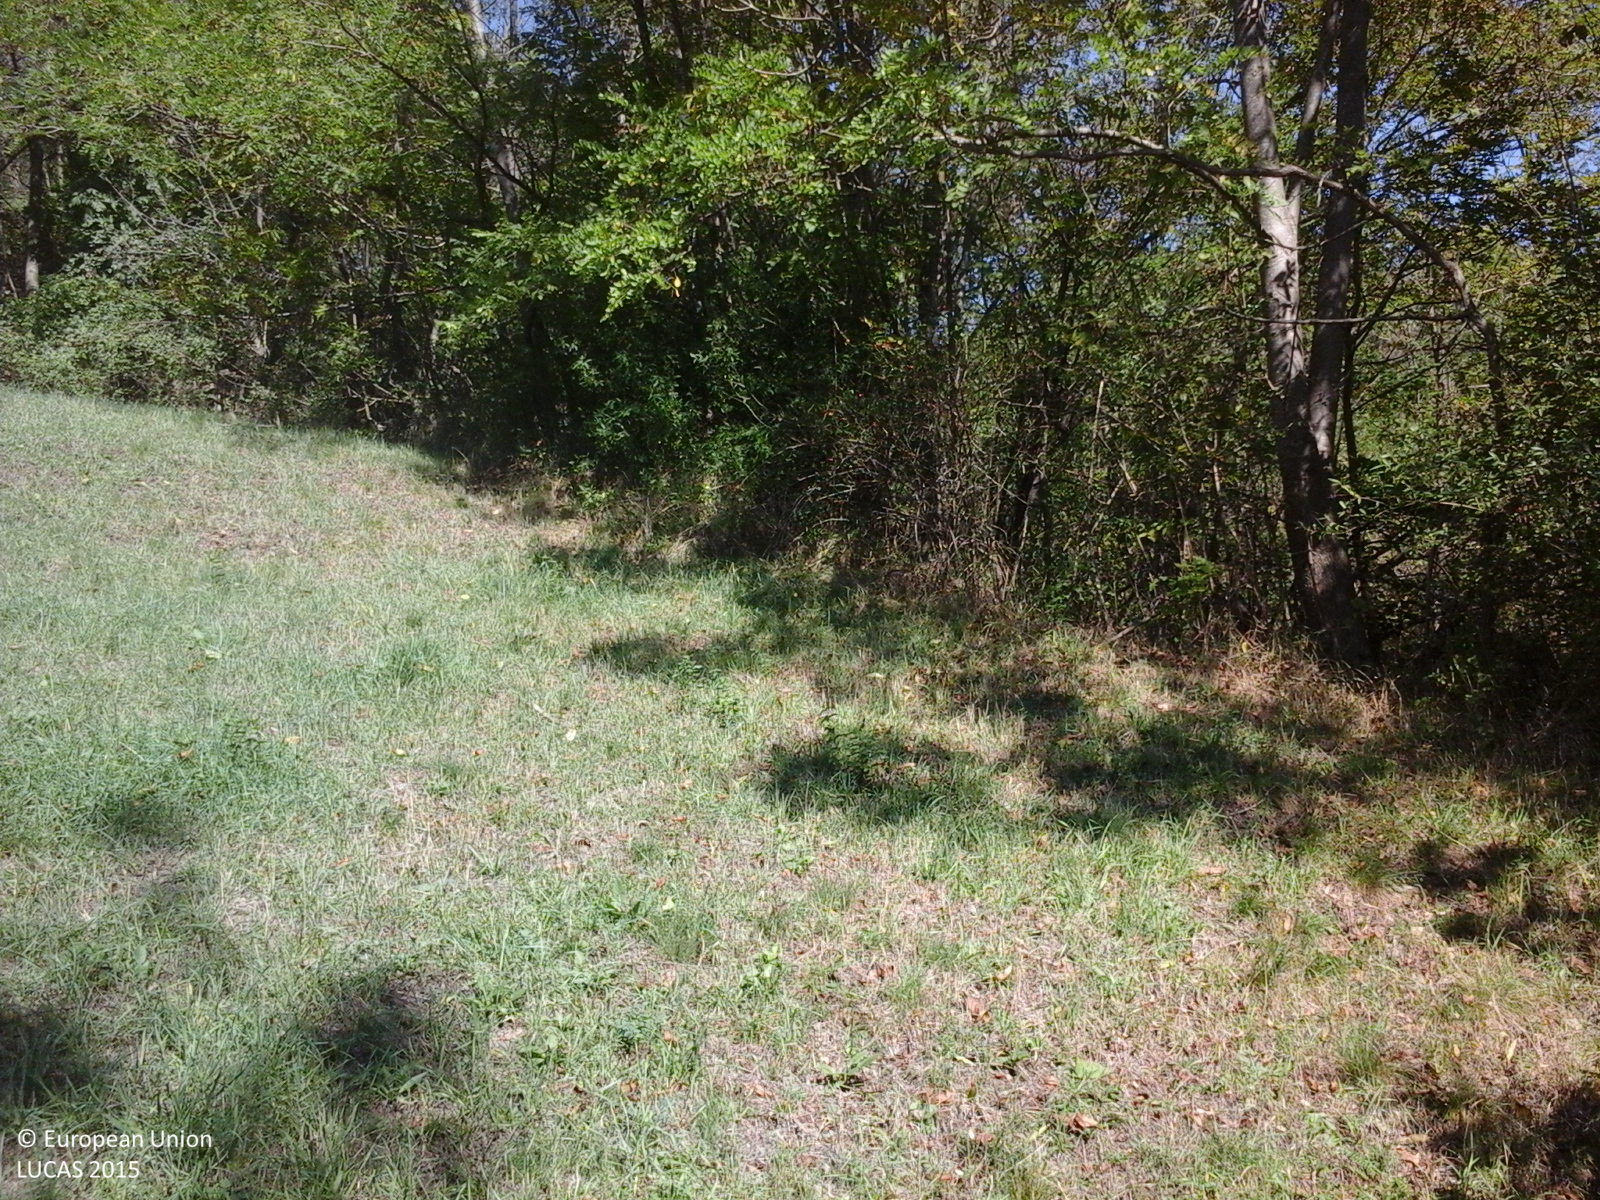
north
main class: Grassland
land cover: Grassland without tree/shrub cover
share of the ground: > 75 %
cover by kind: herbaceous plants 100 %
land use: Agriculture (excluding fallow land and kitchen gardens)
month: October
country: RO
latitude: 46.4446
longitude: 23.4612
